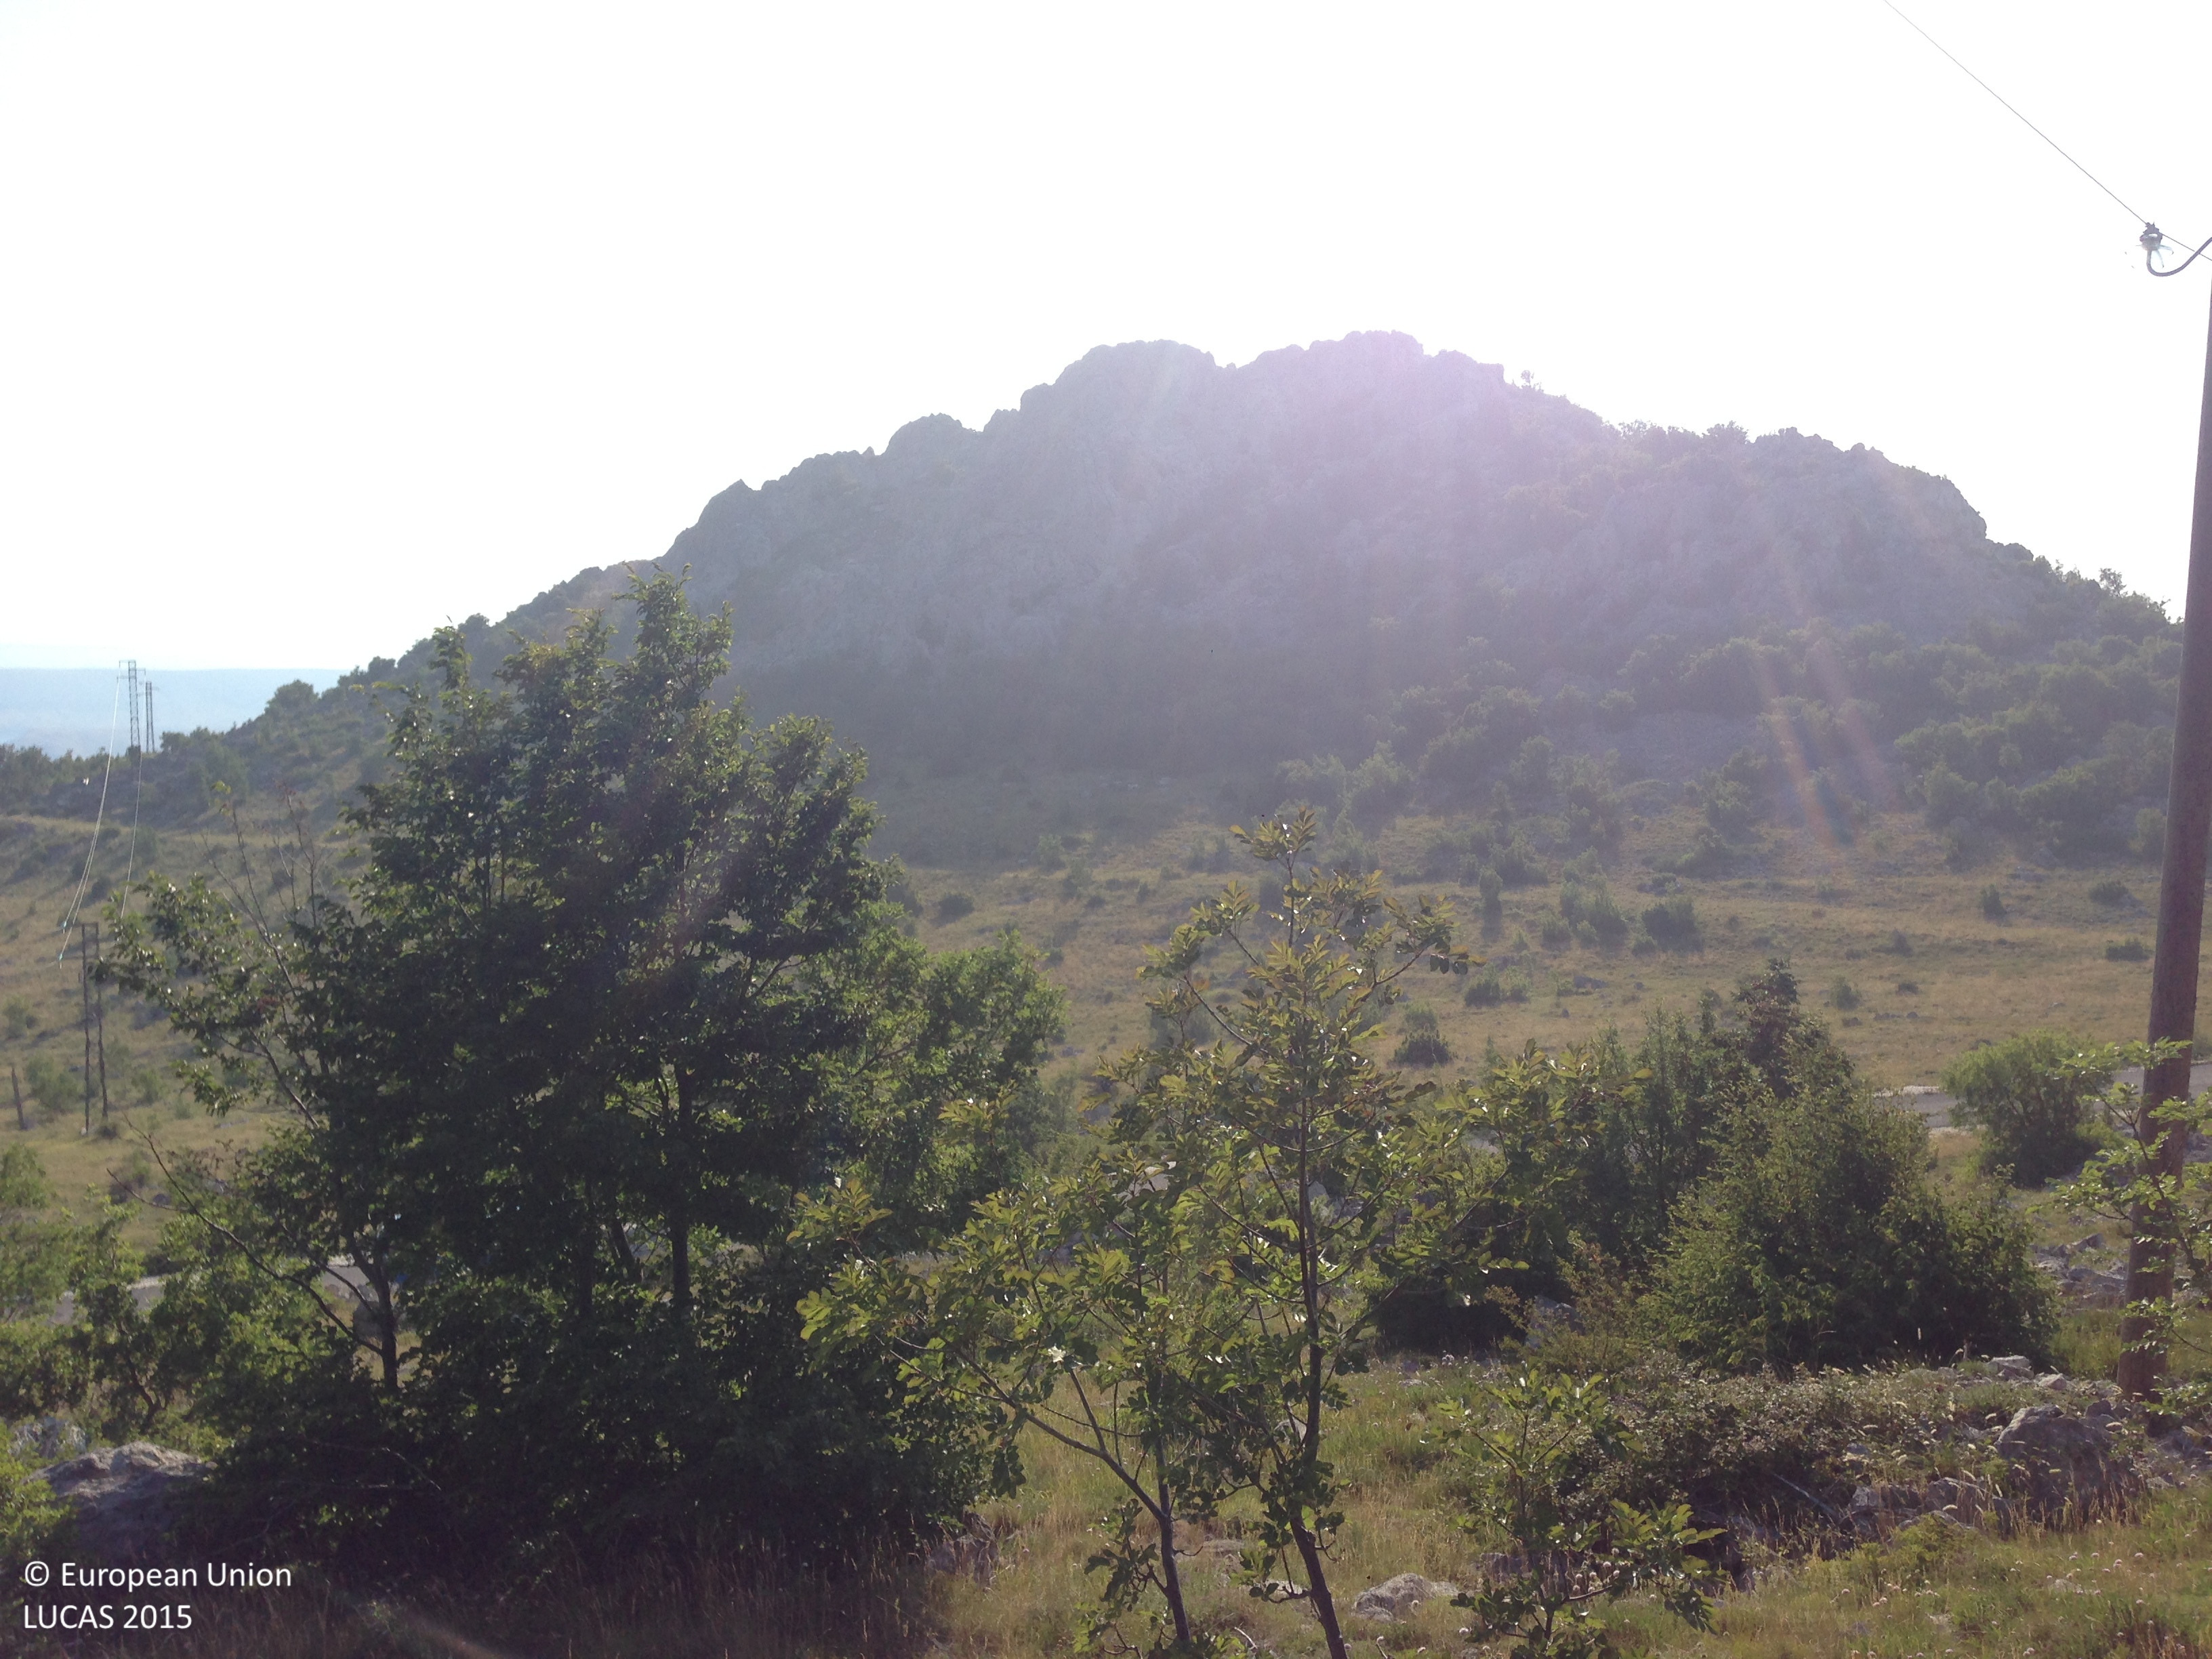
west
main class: Woodland
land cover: Broadleaved woodland
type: thermophilous deciduous forest
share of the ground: > 75 %
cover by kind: broadleaved forest trees 35 %, herbaceous plants 30 %, consolidated bare surface 15 %, shrubs 10 %, unconsolidated bare surface 10 %
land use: Forestry
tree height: < 5 m
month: July
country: HR
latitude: 44.5316
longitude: 15.1148
